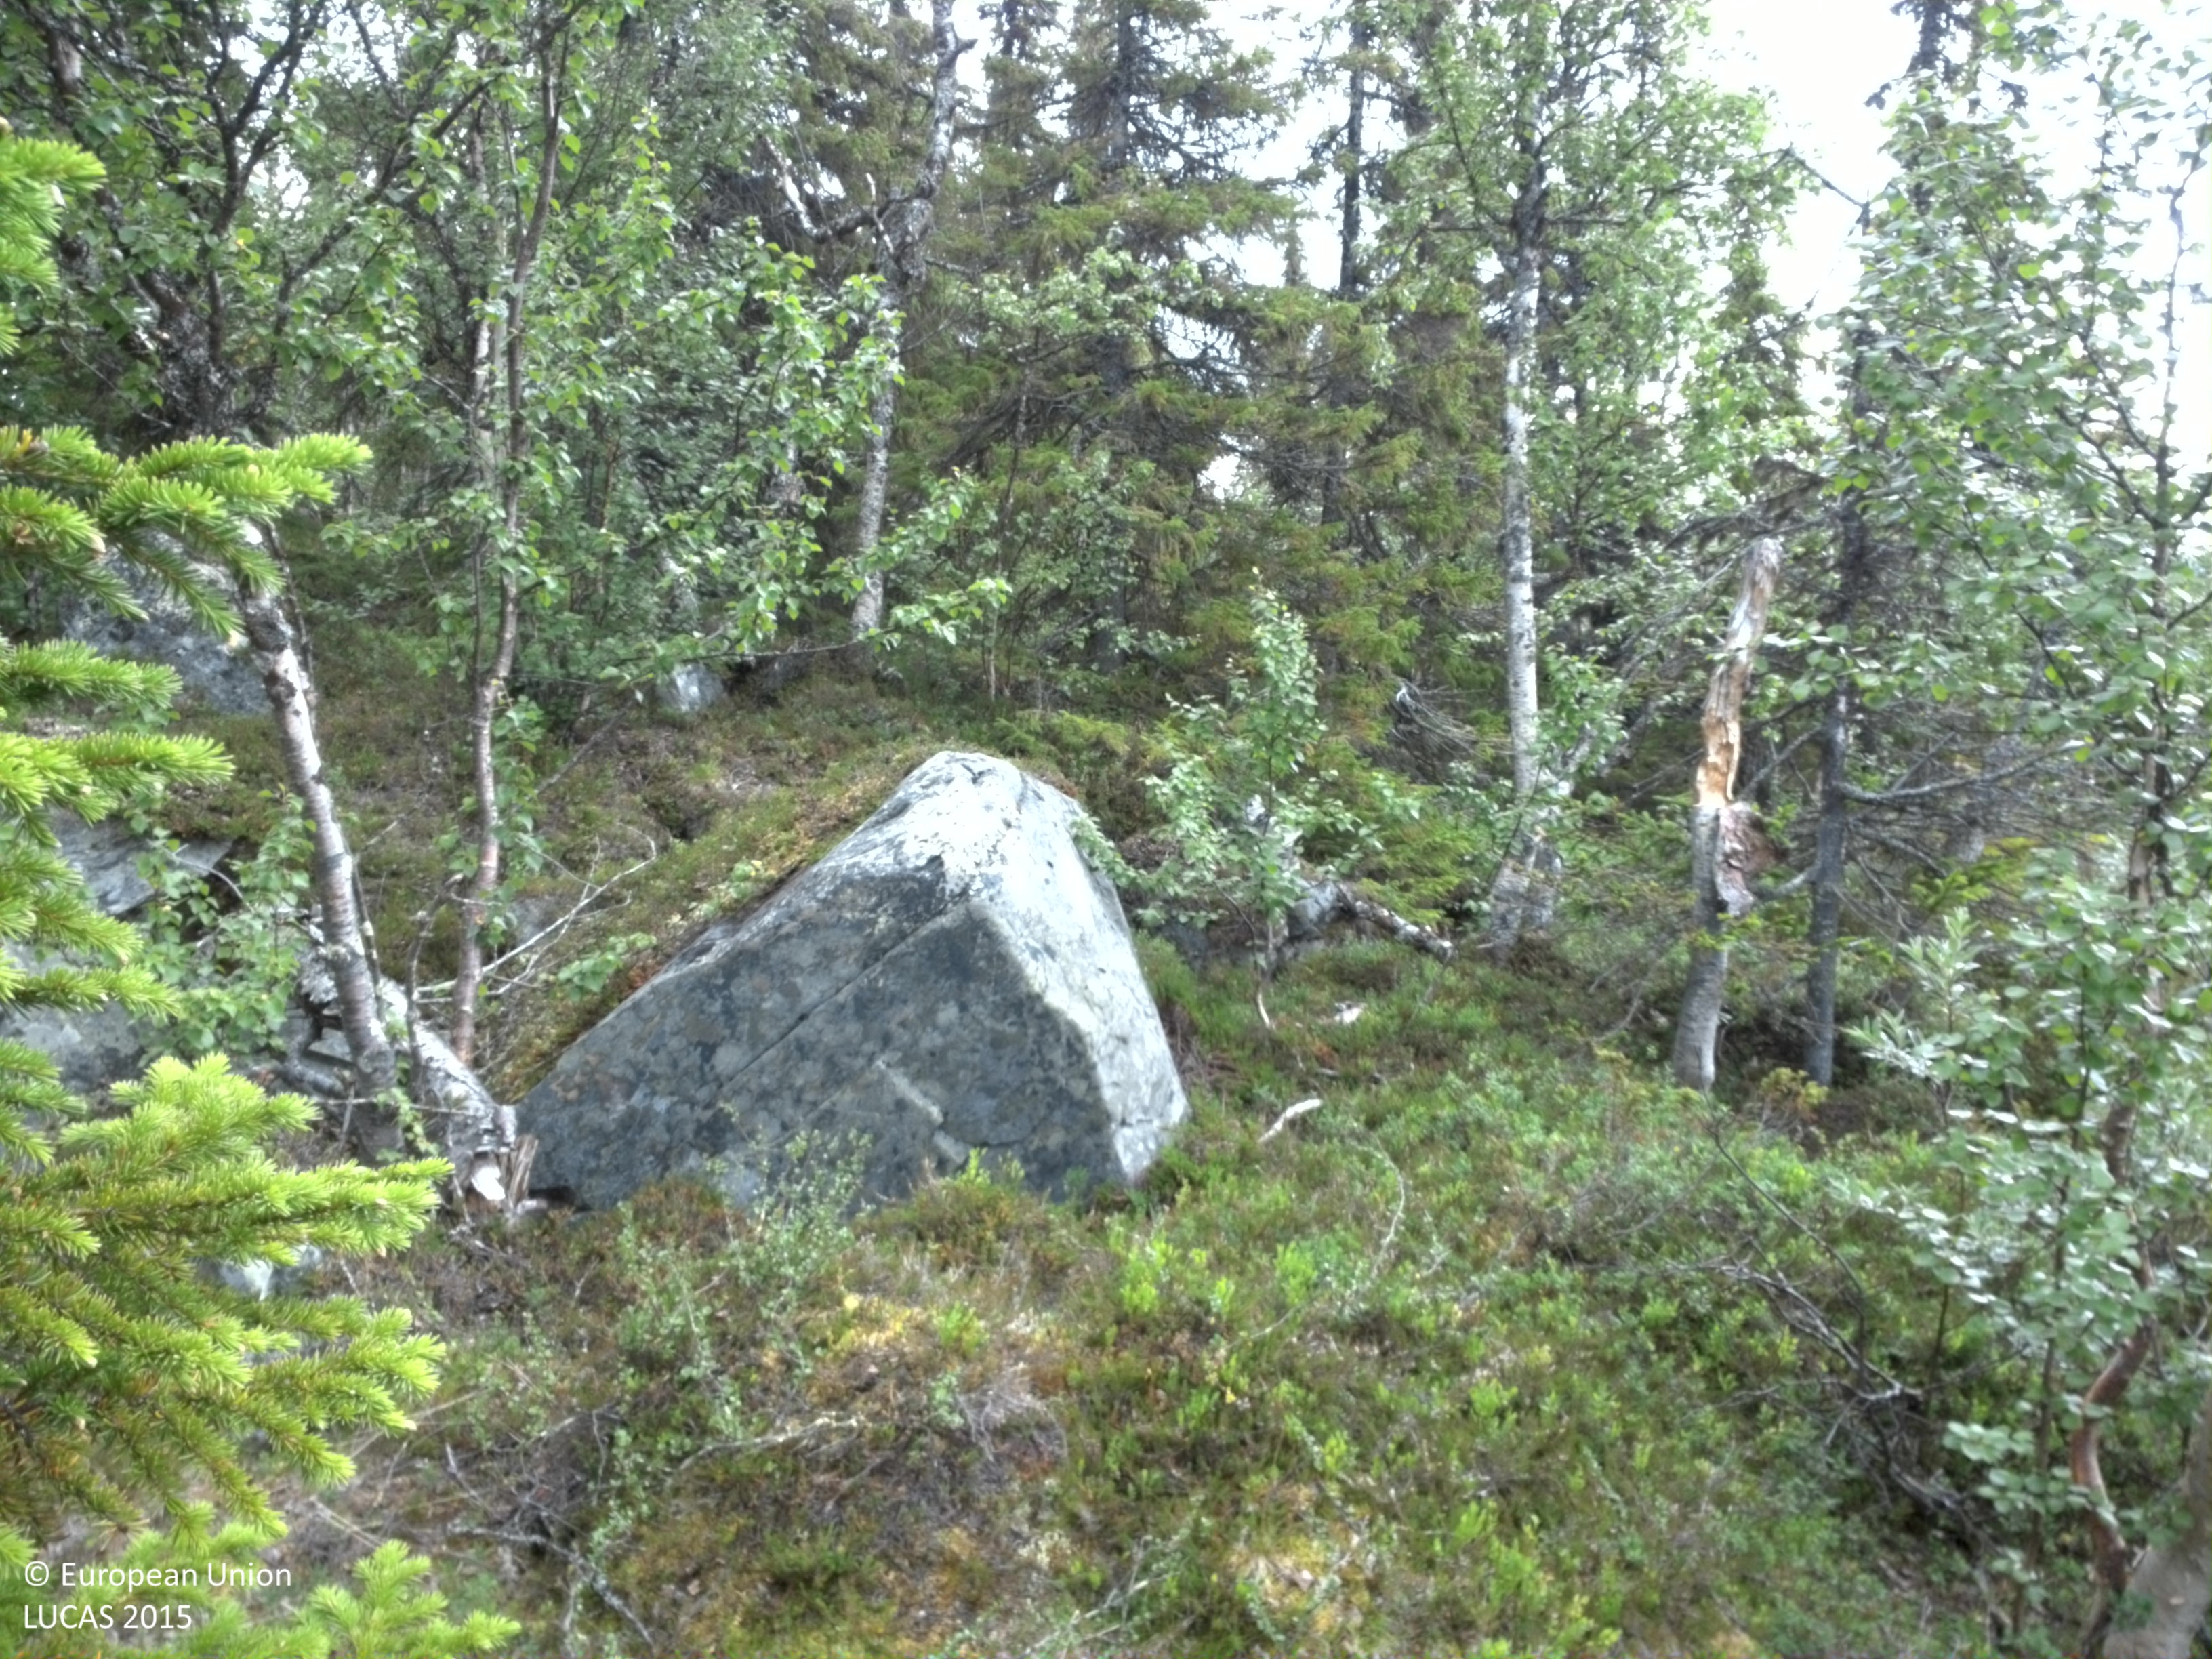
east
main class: Woodland
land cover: Spruce dominated mixed woodland
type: boreal forest
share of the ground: 25 - 50 %
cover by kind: shrubs 55 %, lichens and mosses 20 %, broadleaved forest trees 15 %, coniferous forest trees 10 %
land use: Semi-natural and natural areas not in use
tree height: > 5 m
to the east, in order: Spruce dominated mixed woodland; Peatbogs; Broadleaved woodland; Rivers and streams; Broadleaved woodland; Ditches and canals; Broadleaved woodland; Shrubland without tree cover; Peatbogs
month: August
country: SE
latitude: 65.0075
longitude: 15.5461
